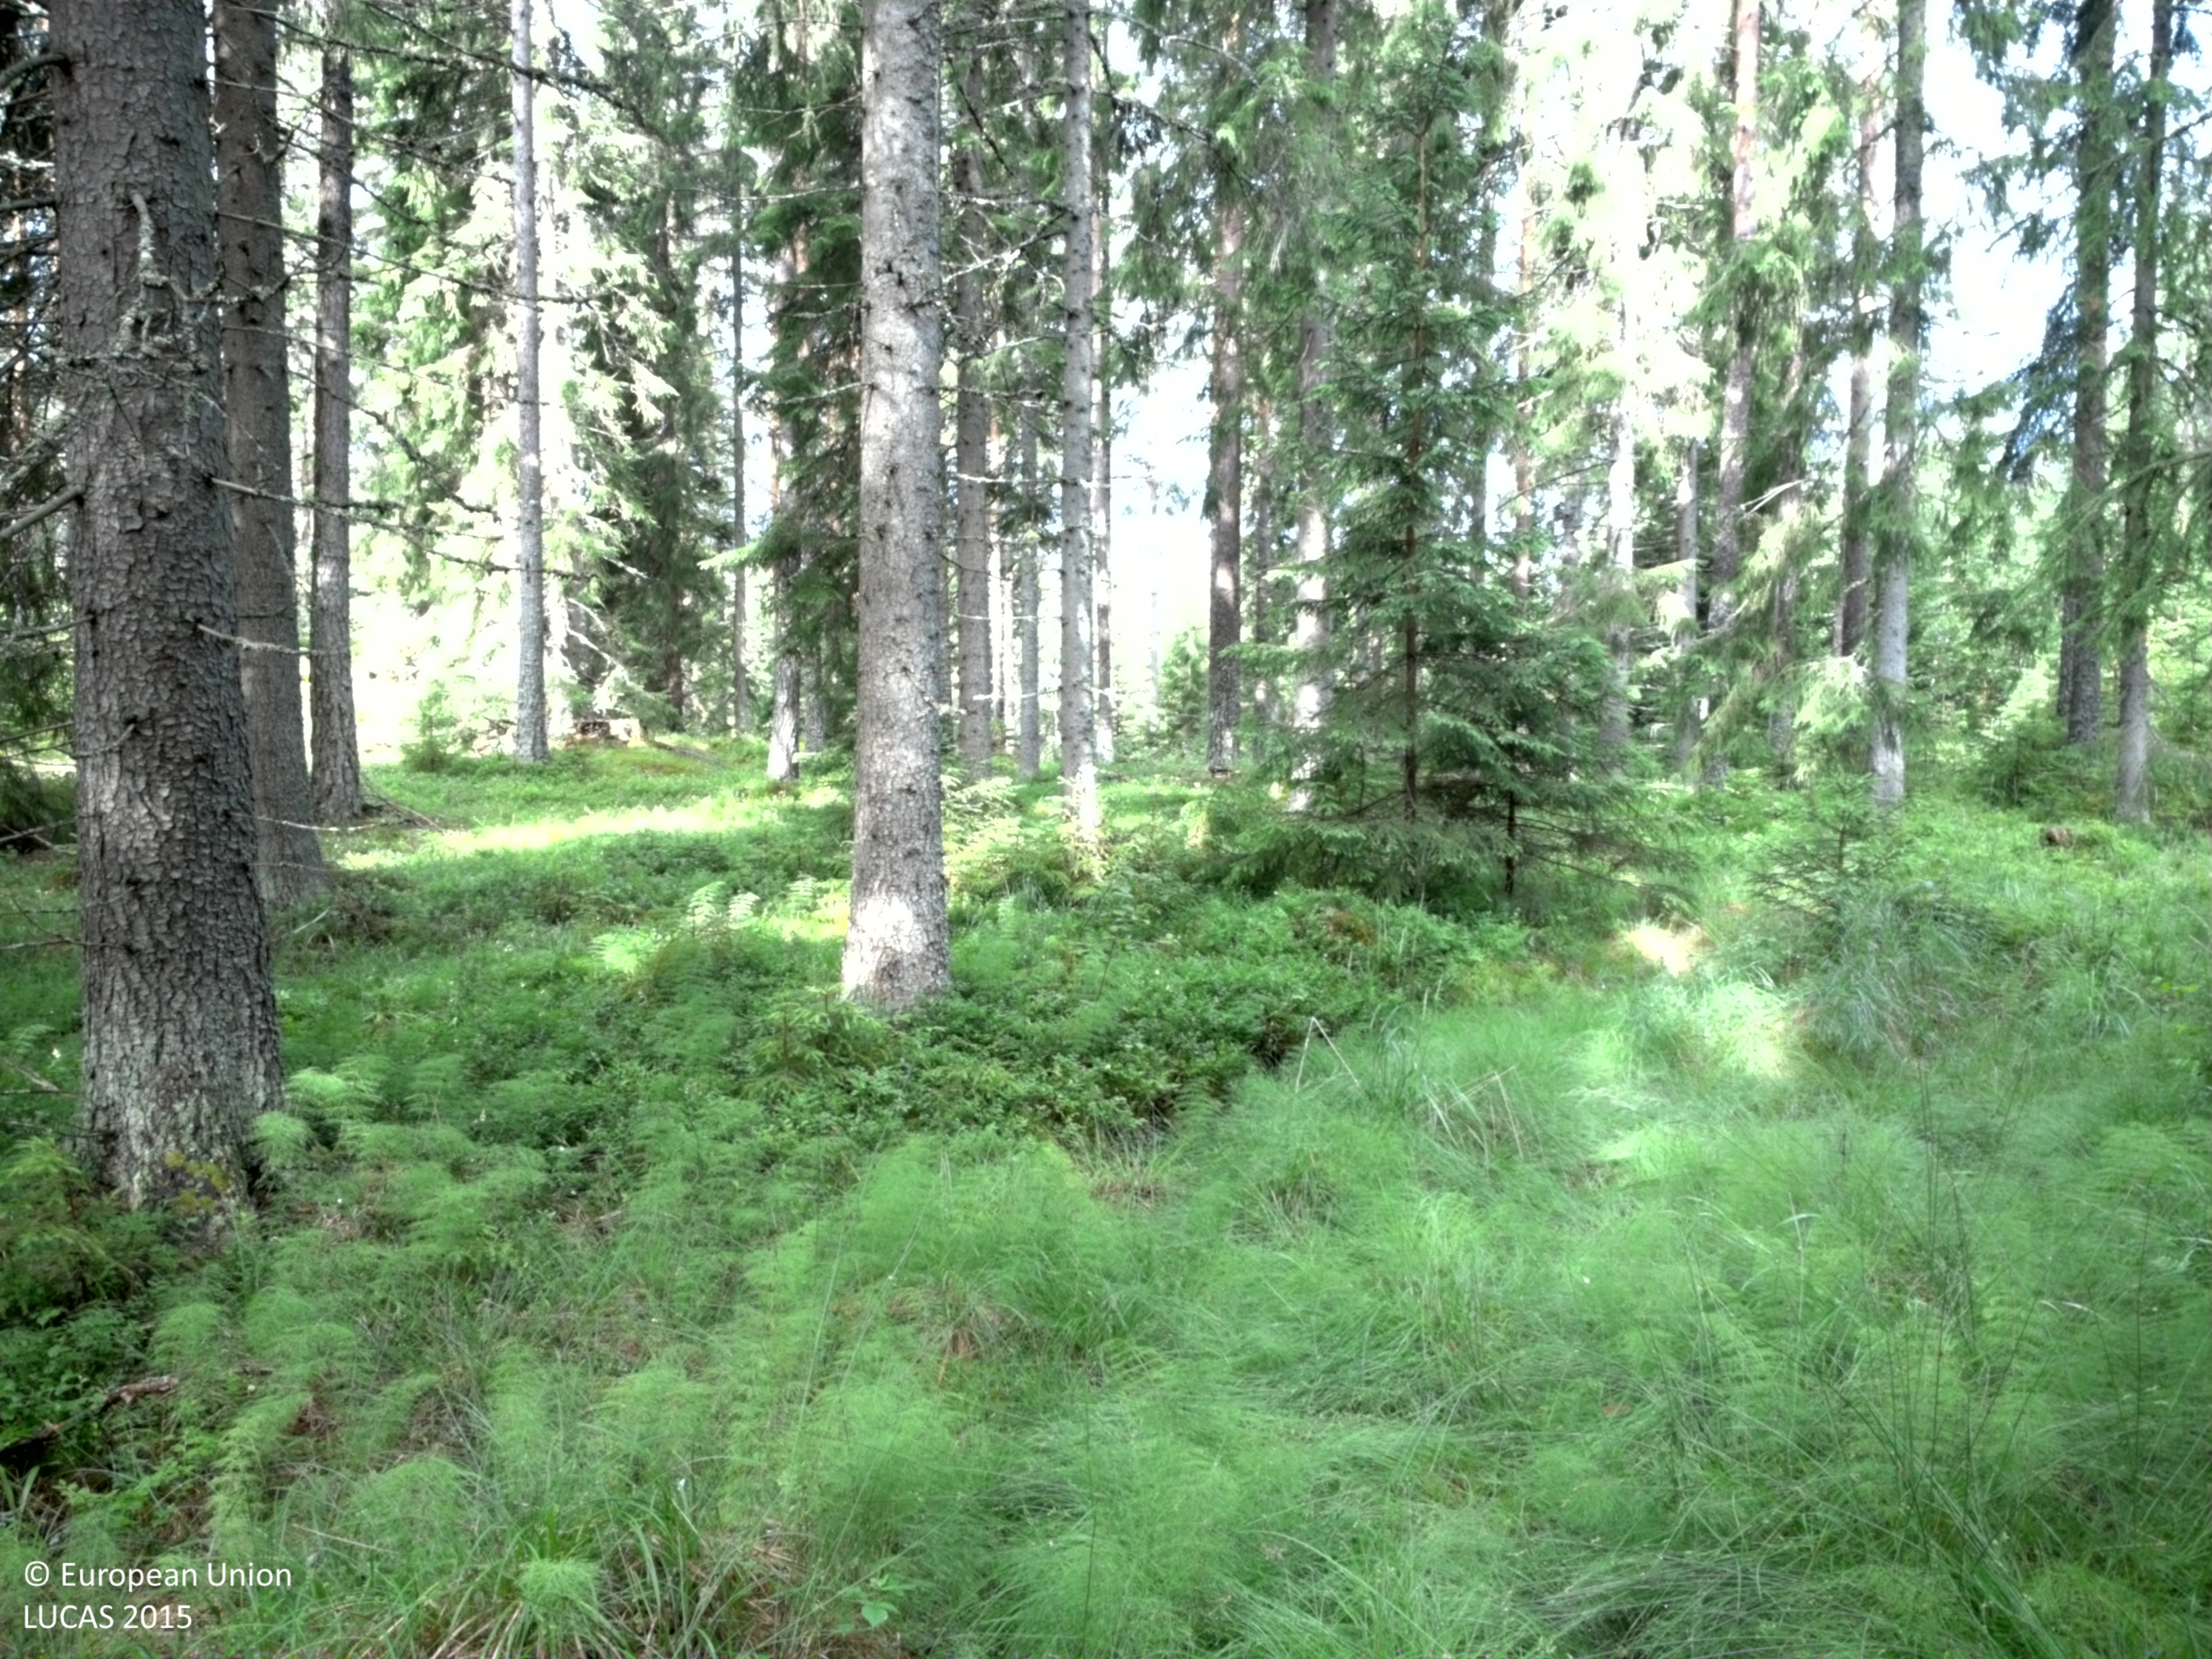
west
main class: Woodland
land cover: Spruce dominated coniferous woodland
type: boreal forest
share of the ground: 50 - 75 %
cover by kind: coniferous forest trees 70 %, herbaceous plants 25 %, broadleaved forest trees 5 %
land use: Forestry
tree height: > 5 m
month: July
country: SE
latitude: 60.0531
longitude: 17.1575
